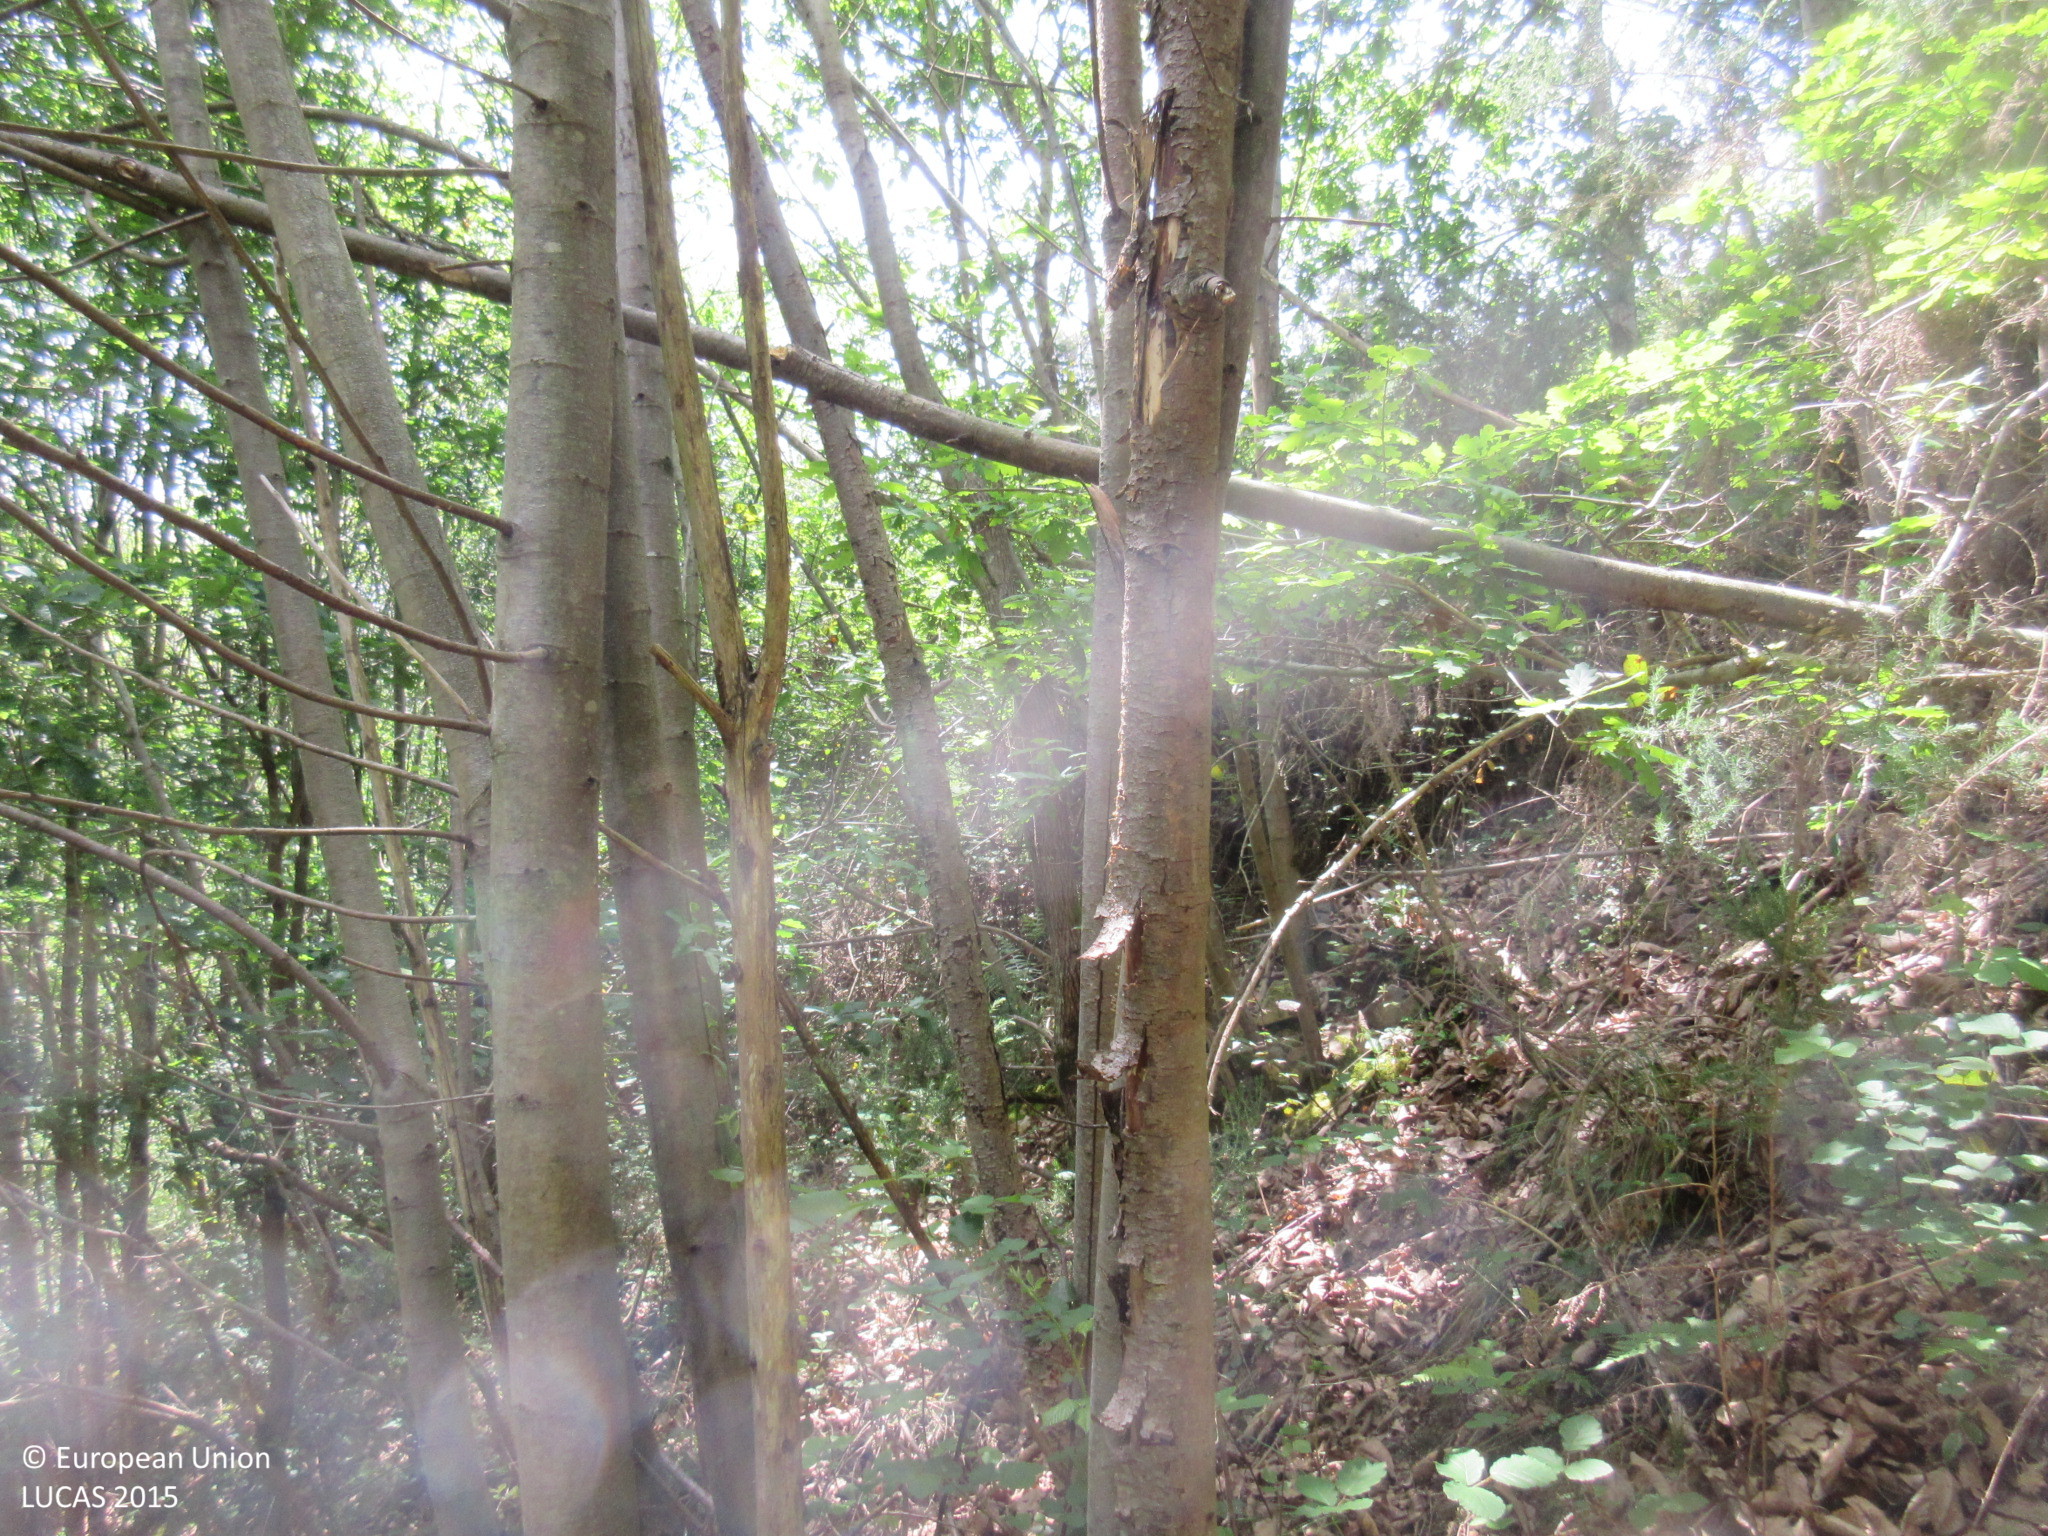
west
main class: Woodland
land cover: Broadleaved woodland
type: acidophilous oak and oak-birch forest
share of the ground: > 75 %
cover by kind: broadleaved forest trees 95 %, shrubs 5 %
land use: Forestry
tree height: > 5 m
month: May
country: ES
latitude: 43.3158
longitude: -5.9080
